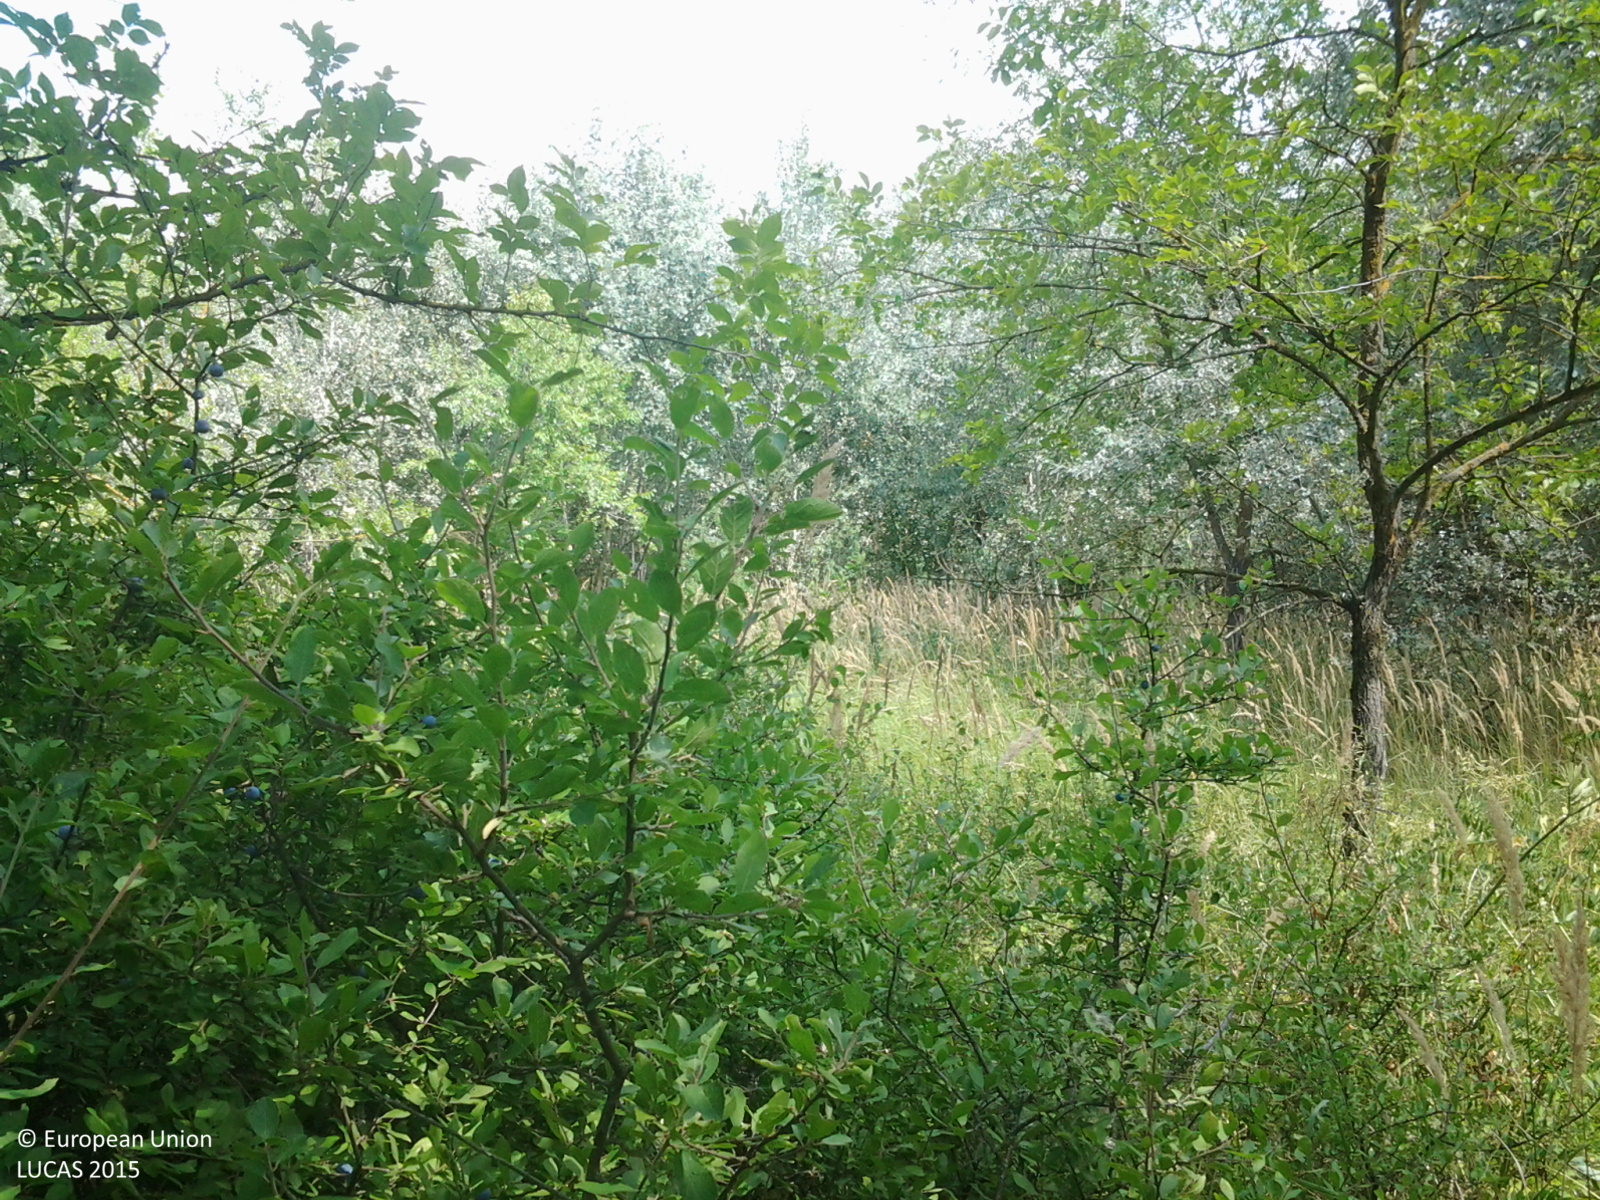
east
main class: Woodland
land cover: Broadleaved woodland
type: non-riverine alder, birch or aspen forest
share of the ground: > 75 %
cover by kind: broadleaved forest trees 75 %, herbaceous plants 15 %, shrubs 10 %
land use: Forestry
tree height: > 5 m
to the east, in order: Broadleaved woodland
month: July
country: HU
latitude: 46.8366
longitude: 21.5121
